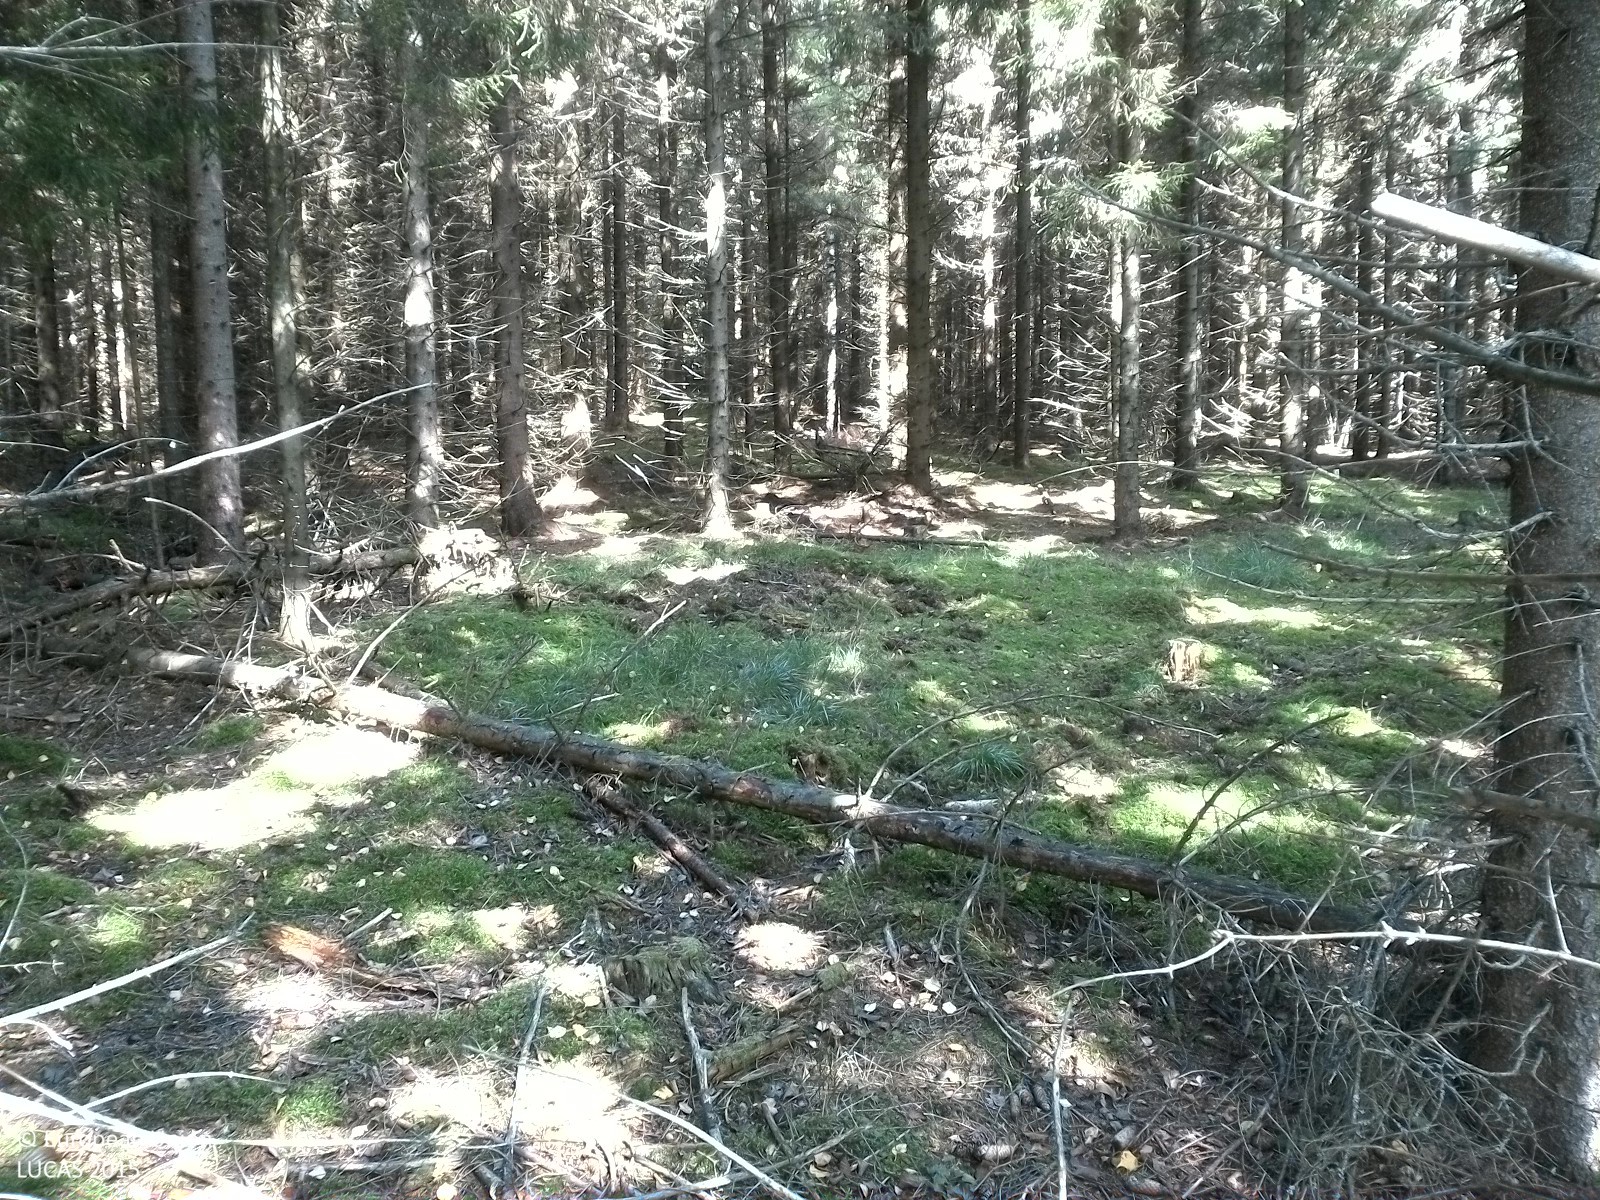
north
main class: Woodland
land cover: Spruce dominated coniferous woodland
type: boreal forest
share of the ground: 50 - 75 %
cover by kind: coniferous forest trees 70 %, herbaceous plants 10 %, lichens and mosses 10 %, unconsolidated bare surface 10 %
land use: Forestry
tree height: > 5 m
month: August
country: SE
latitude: 58.9489
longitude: 15.6420
